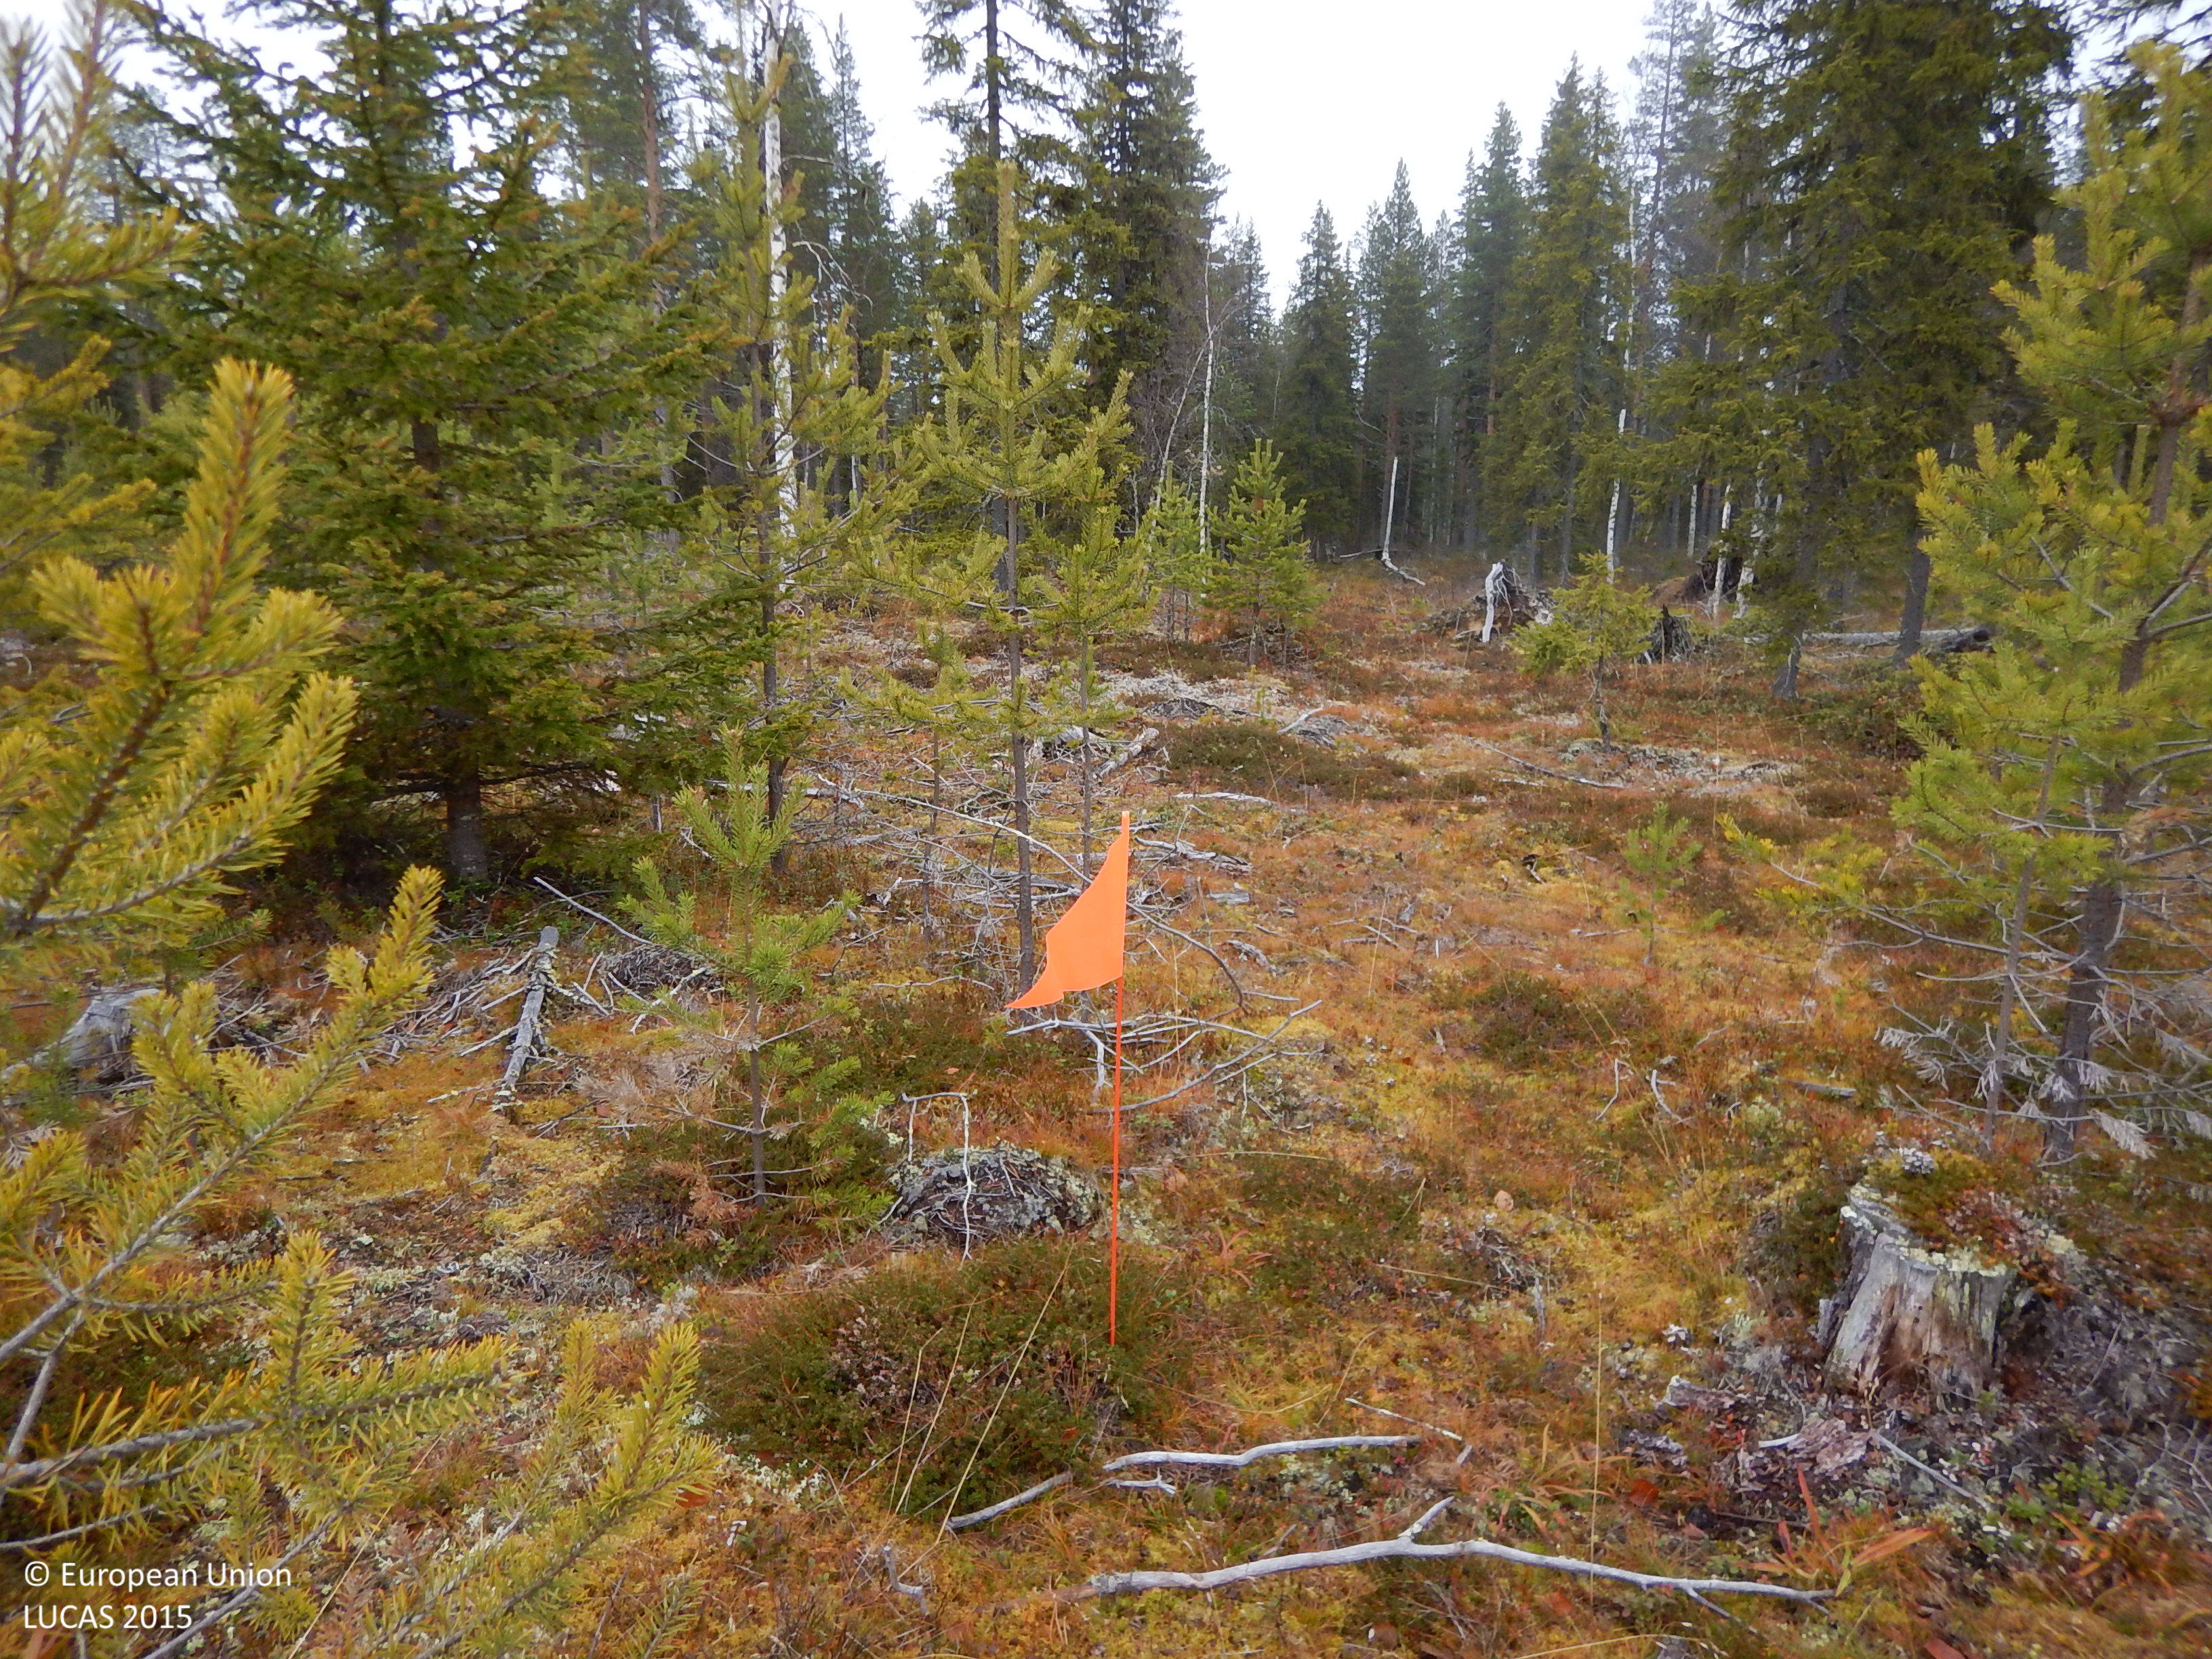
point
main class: Woodland
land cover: Pine dominated coniferous woodland
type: boreal forest
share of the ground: 50 - 75 %
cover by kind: coniferous forest trees 45 %, shrubs 20 %, herbaceous plants 15 %, lichens and mosses 15 %, broadleaved forest trees 5 %
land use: Forestry
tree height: < 5 m
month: October
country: SE
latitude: 65.1643
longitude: 20.1895
